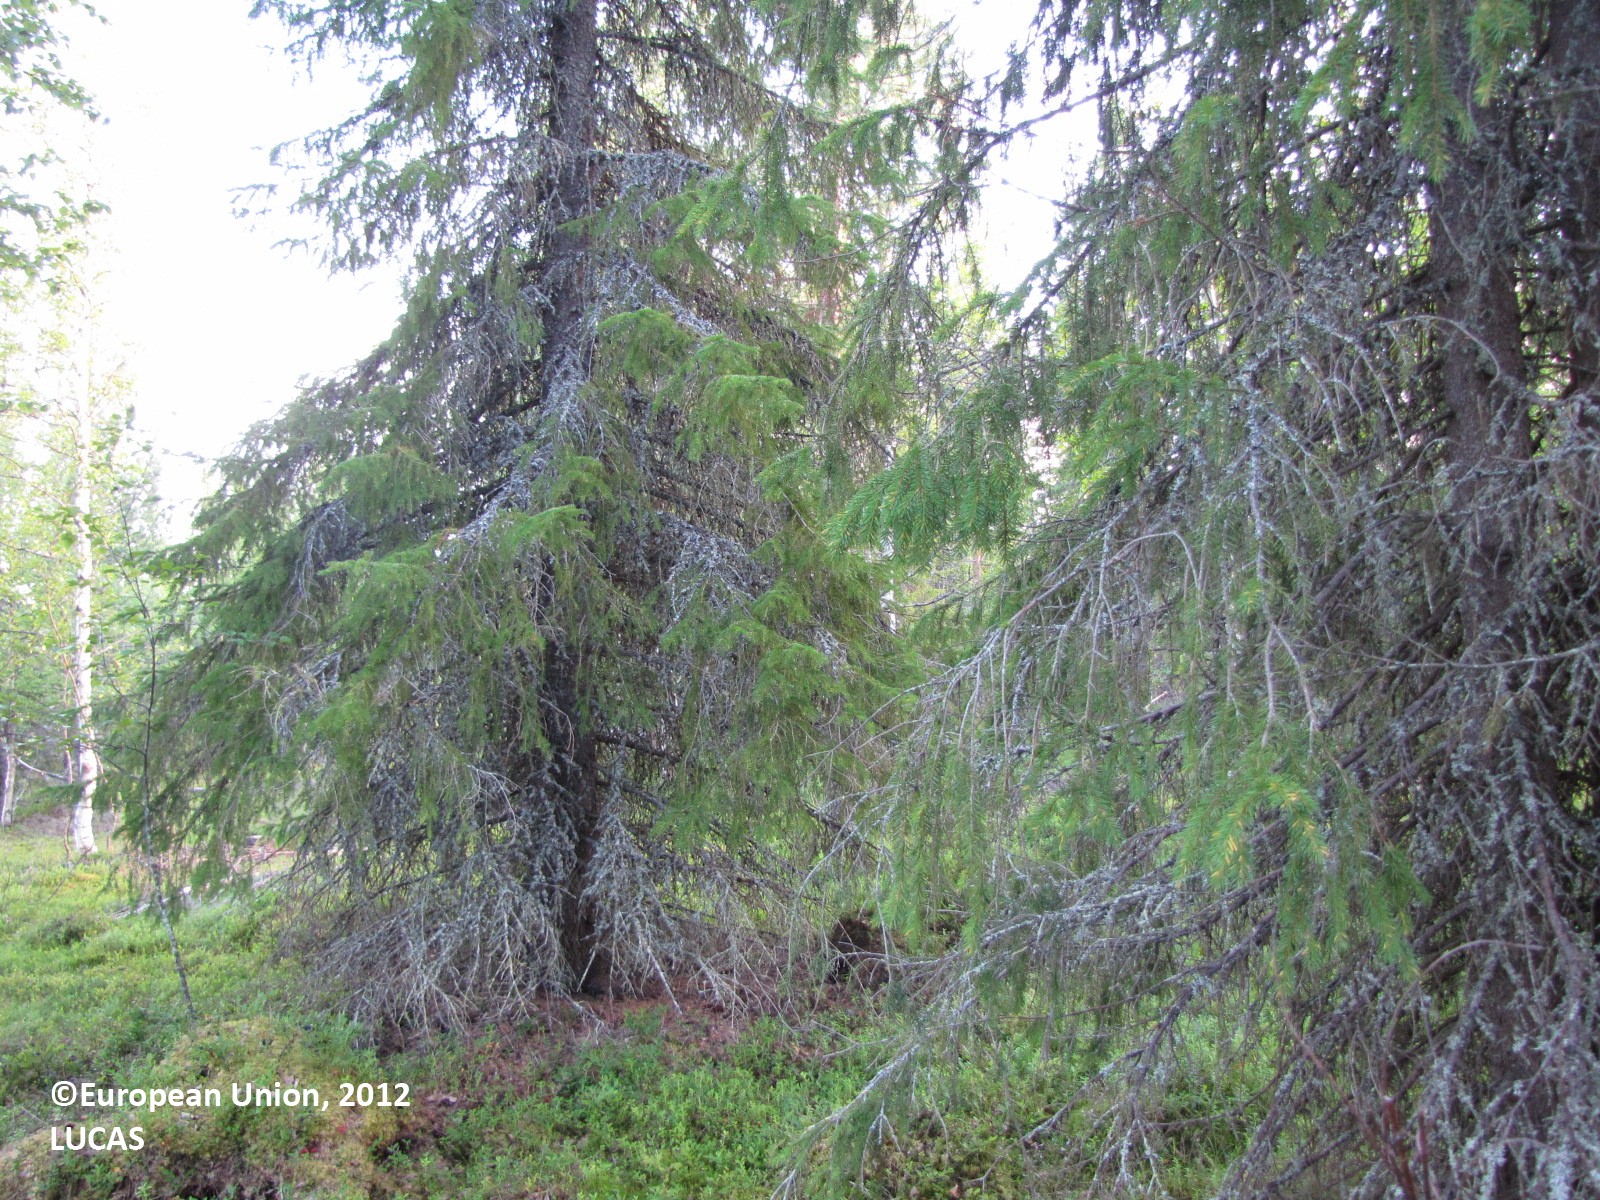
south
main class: Woodland
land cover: Spruce dominated mixed woodland
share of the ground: 25 - 50 %
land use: Forestry
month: August
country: FI
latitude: 66.8040
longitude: 24.9973
